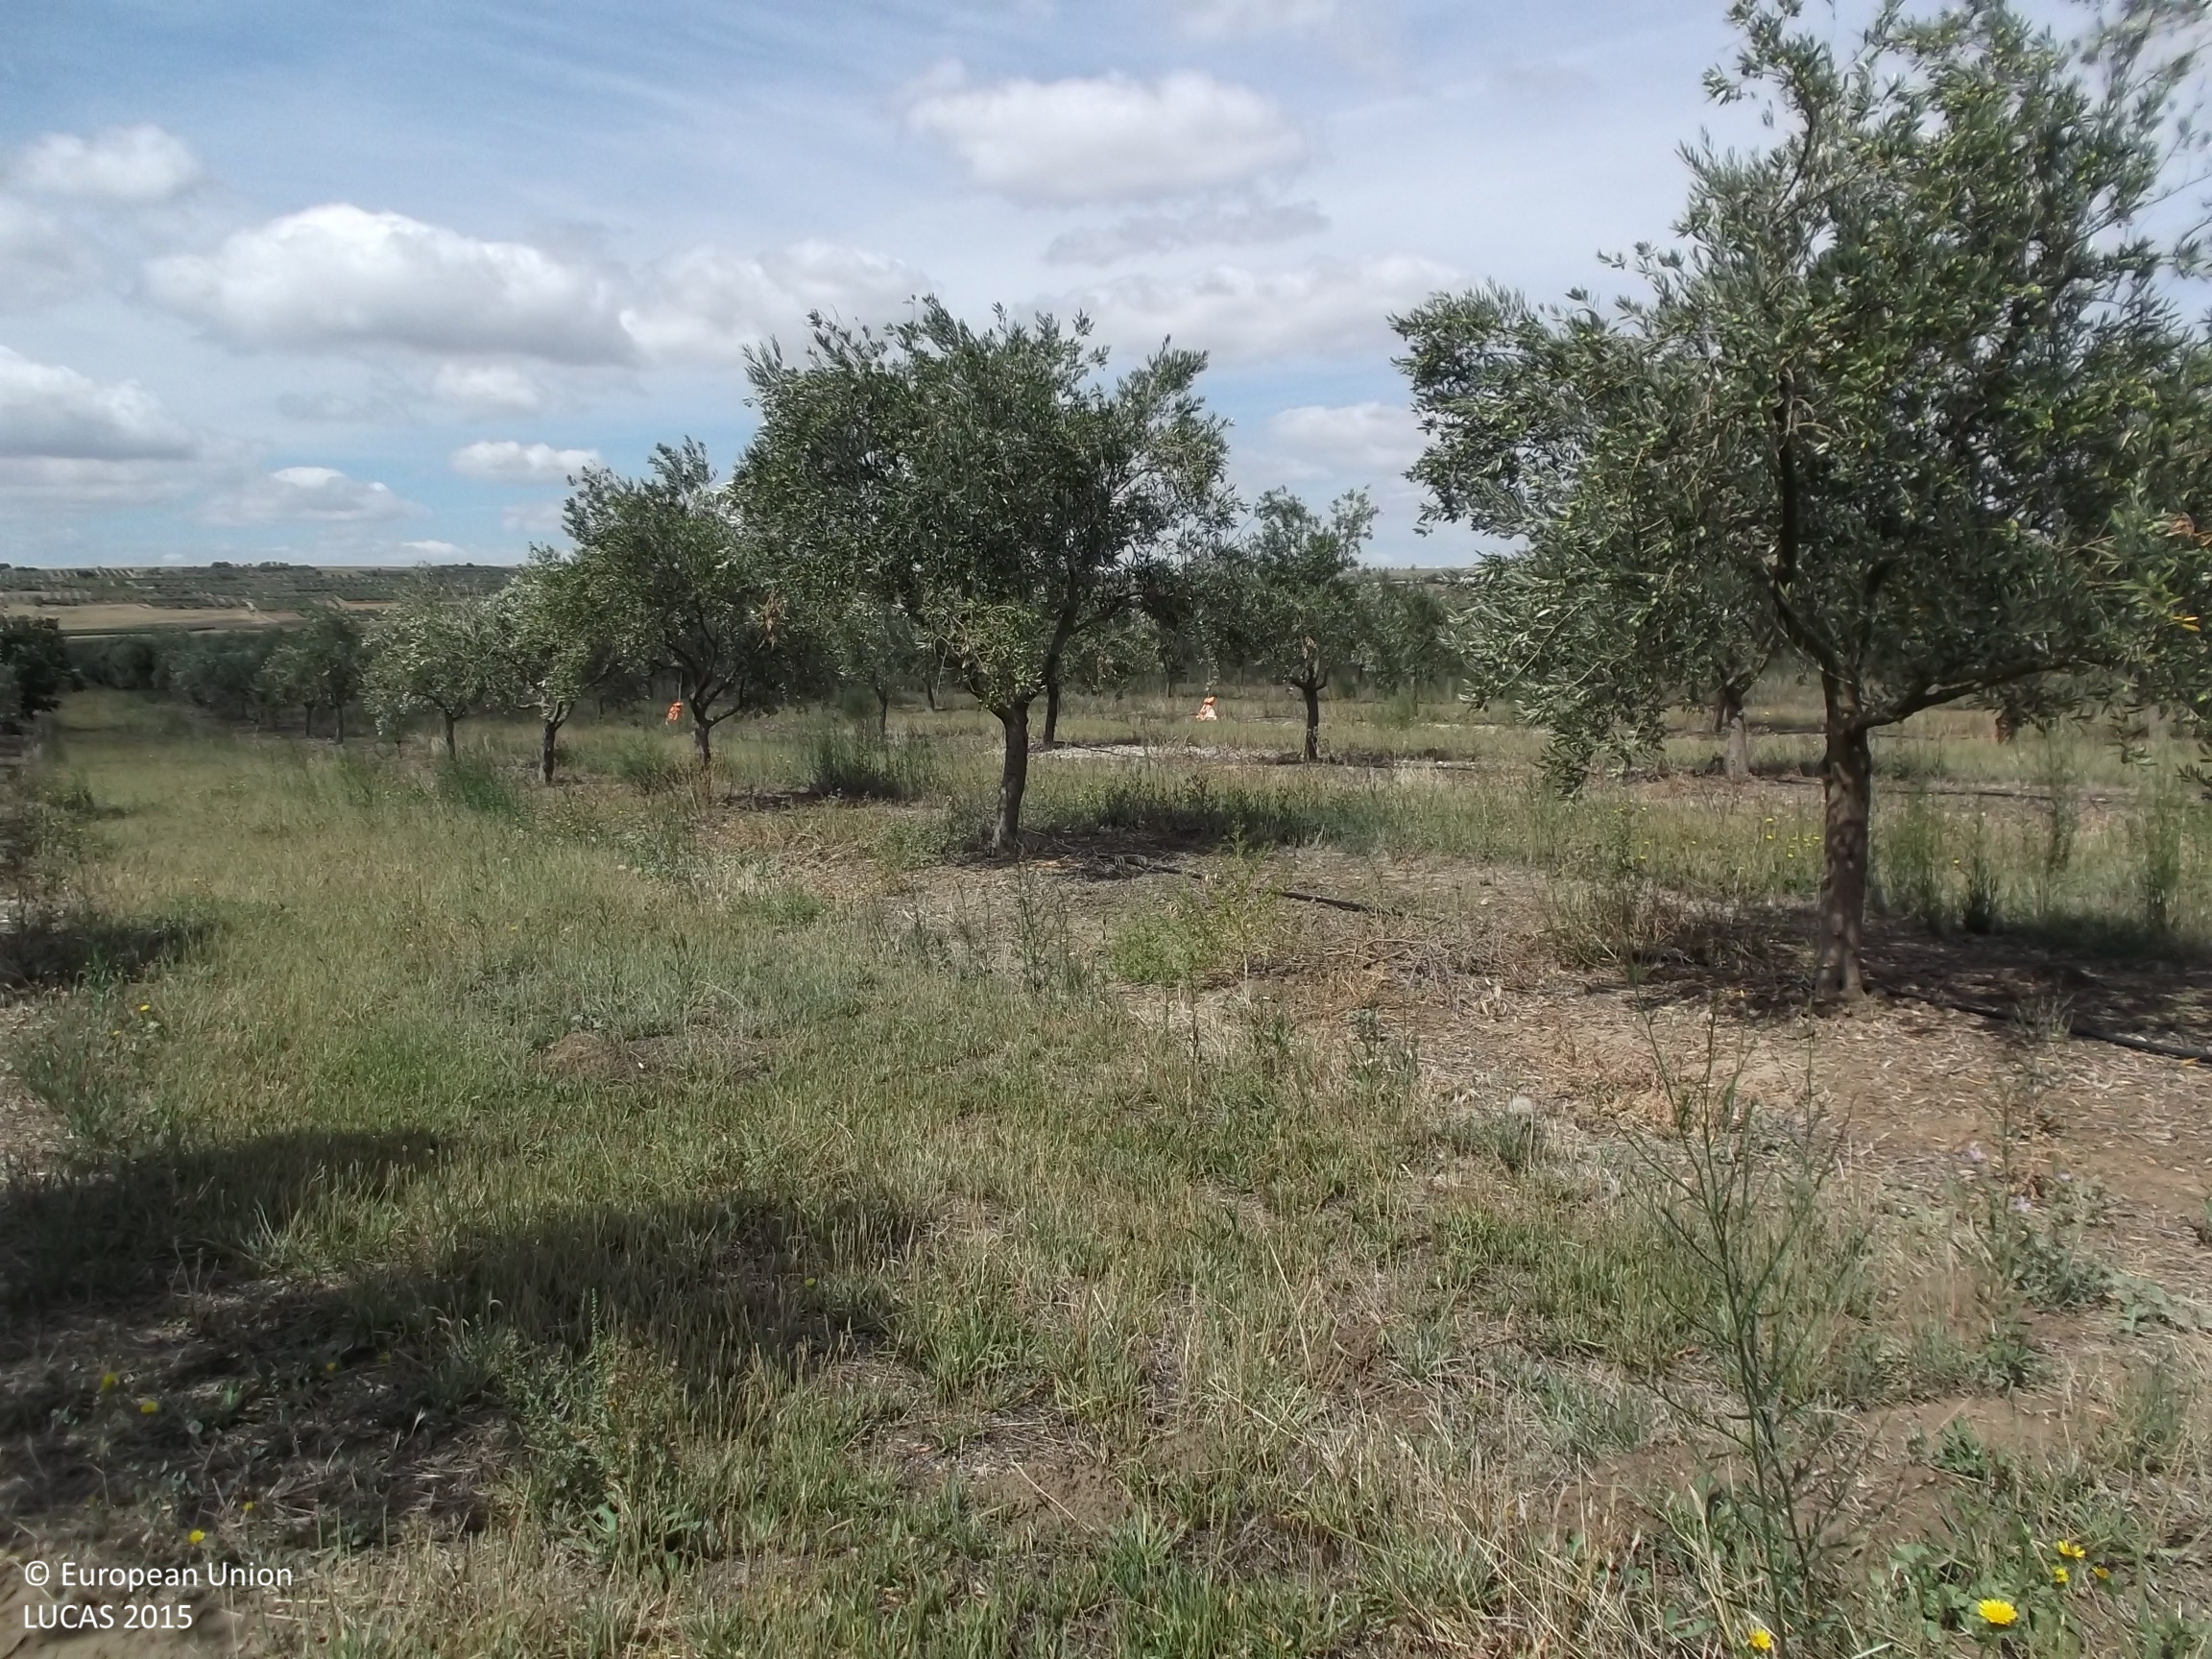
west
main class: Cropland
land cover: Olive groves
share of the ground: 10 - 25 %
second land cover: Spontaneously vegetated surfaces
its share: > 75 %
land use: Agriculture (excluding fallow land and kitchen gardens)
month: August
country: ES
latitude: 42.4736
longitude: -2.0947
